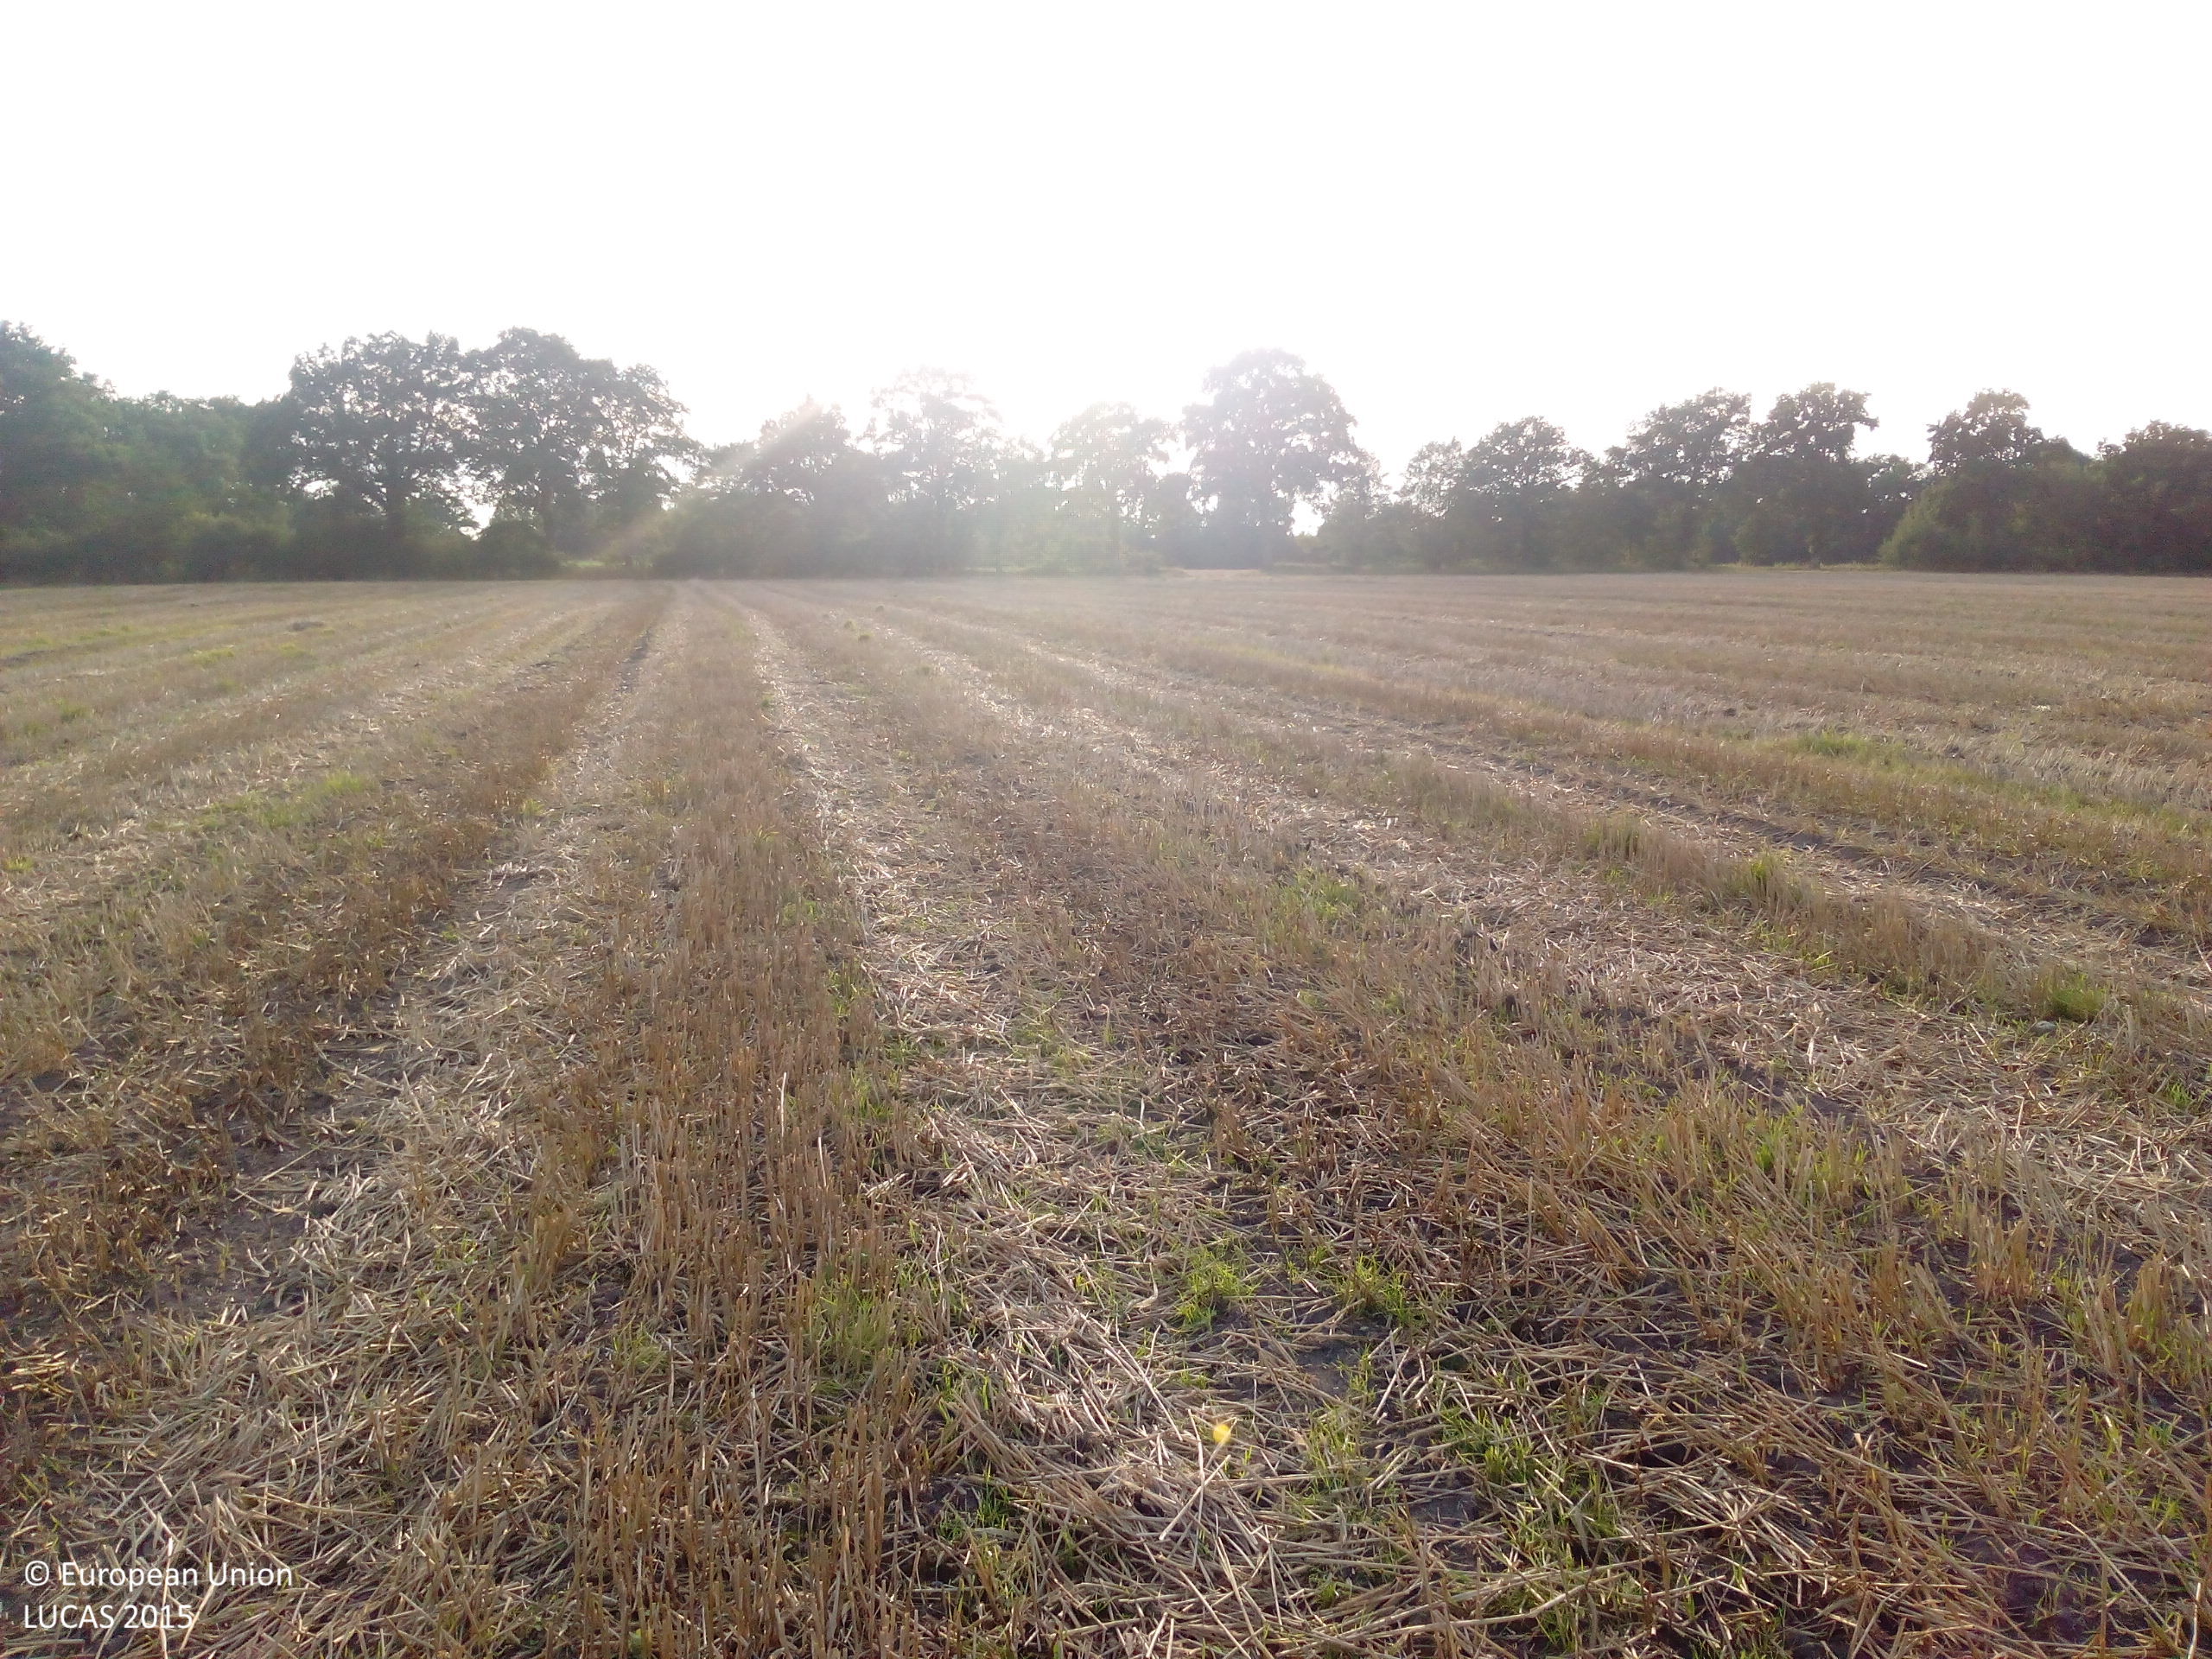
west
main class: Cropland
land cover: Rye
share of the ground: 50 - 75 %
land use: Agriculture (excluding fallow land and kitchen gardens)
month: August
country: DE
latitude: 53.7074
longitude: 9.9243
